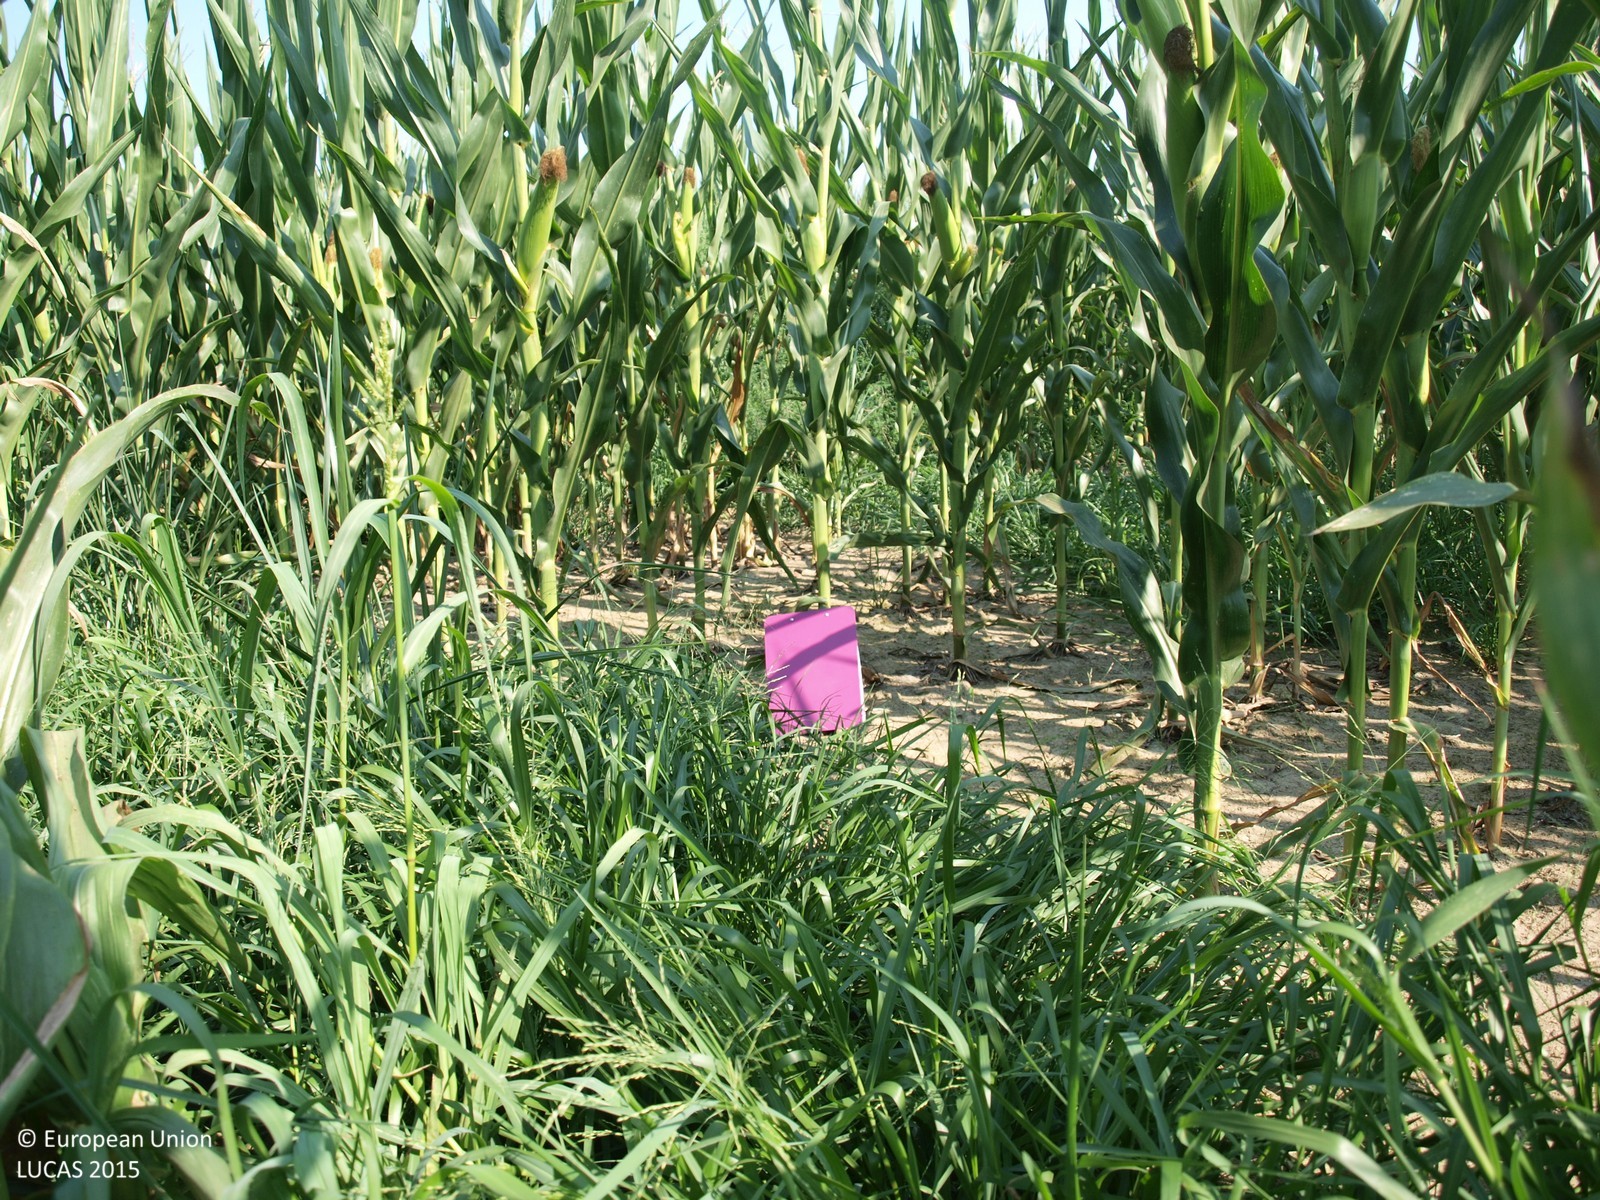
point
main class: Cropland
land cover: Maize
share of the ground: > 75 %
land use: Agriculture (excluding fallow land and kitchen gardens)
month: August
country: HR
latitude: 45.8641
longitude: 16.5042
